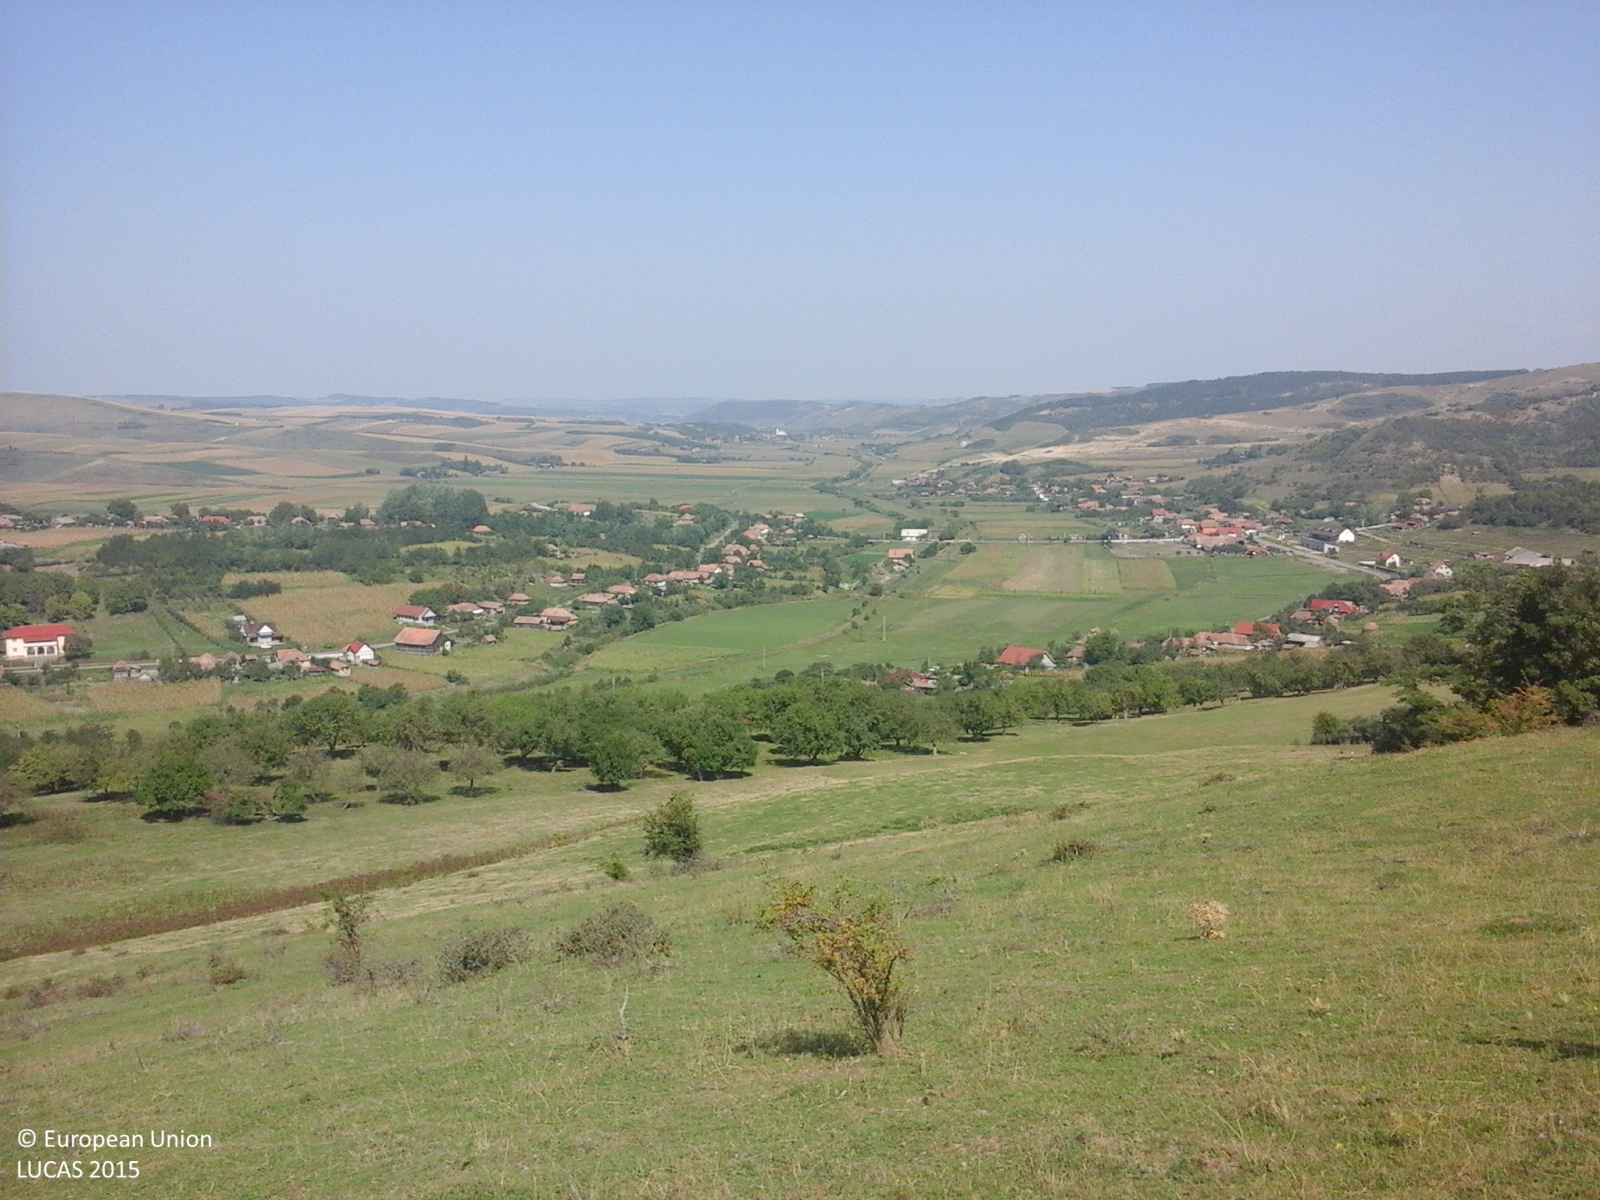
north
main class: Grassland
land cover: Grassland with sparse tree/shrub cover
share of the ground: > 75 %
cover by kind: herbaceous plants 95 %, broadleaved forest trees 5 %
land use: Fallow land
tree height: < 5 m
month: September
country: RO
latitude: 46.7217
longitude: 24.4129
